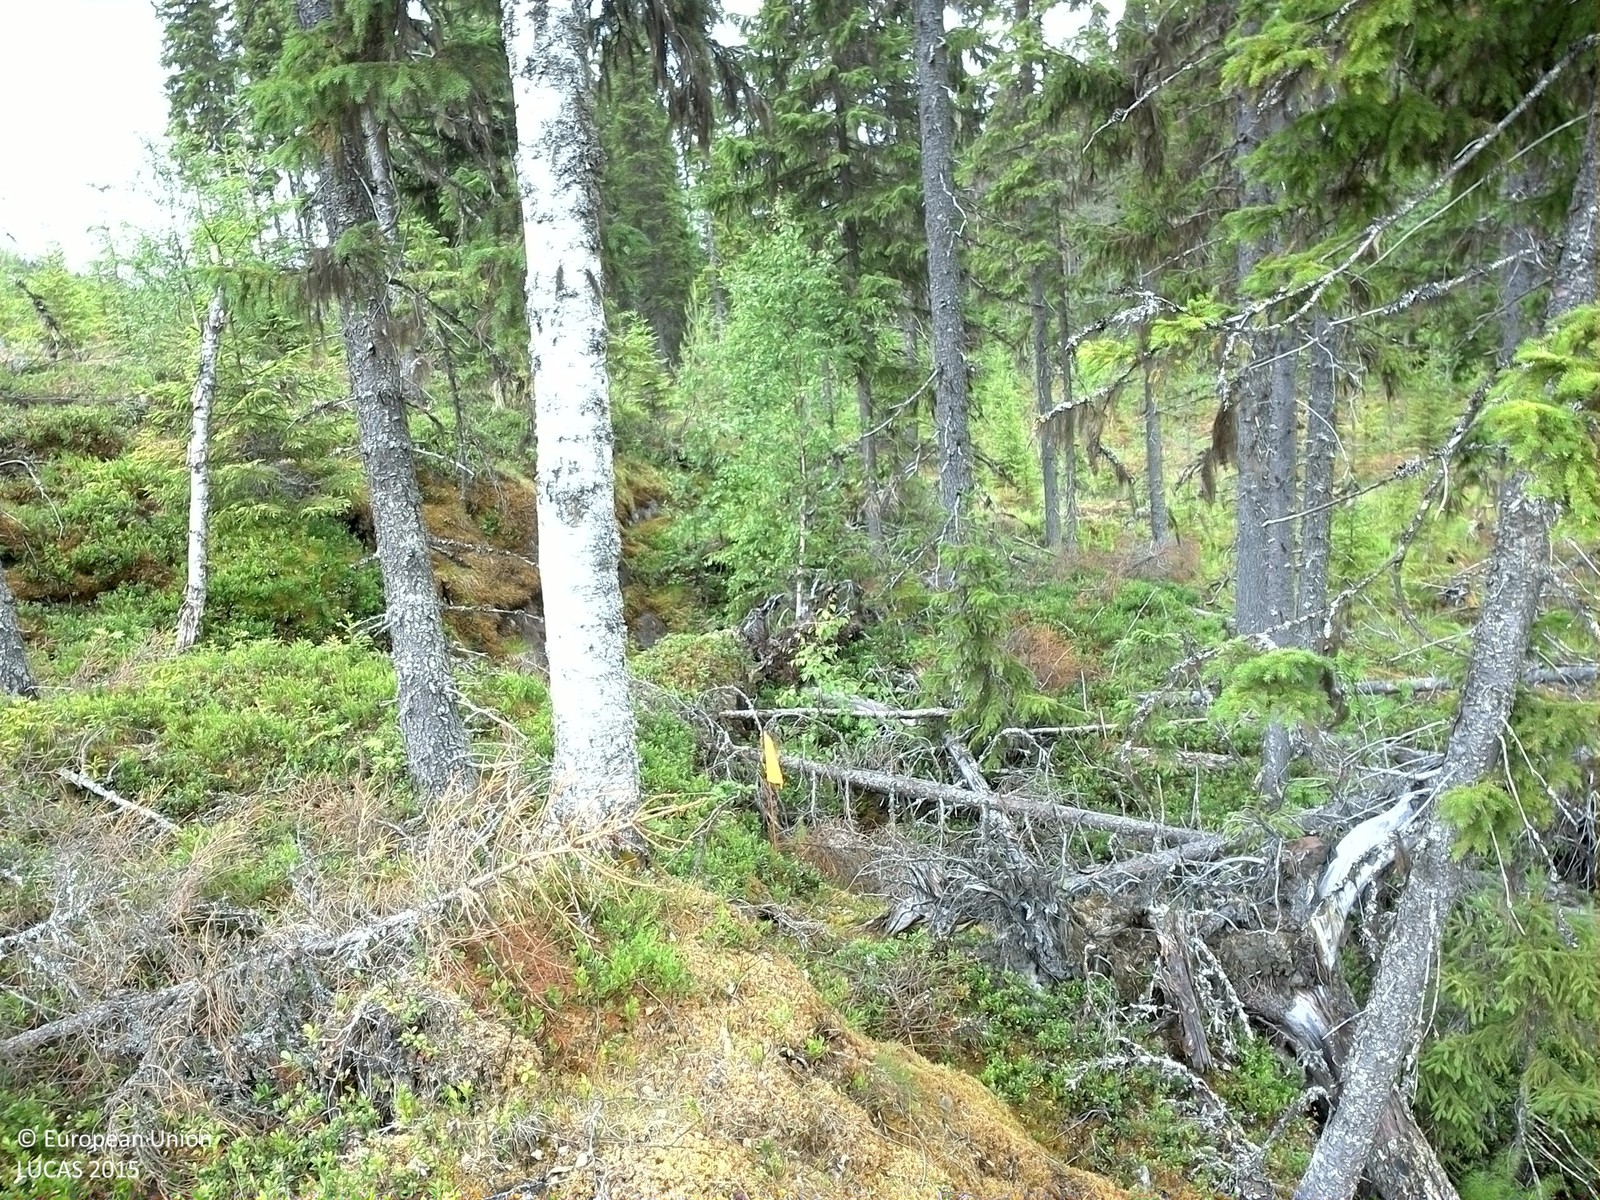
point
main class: Woodland
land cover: Spruce dominated coniferous woodland
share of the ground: 25 - 50 %
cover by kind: coniferous forest trees 30 %, shrubs 30 %, lichens and mosses 20 %, herbaceous plants 15 %, broadleaved forest trees 5 %
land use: Forestry
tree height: > 5 m
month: July
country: SE
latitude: 63.5214
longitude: 18.3986
